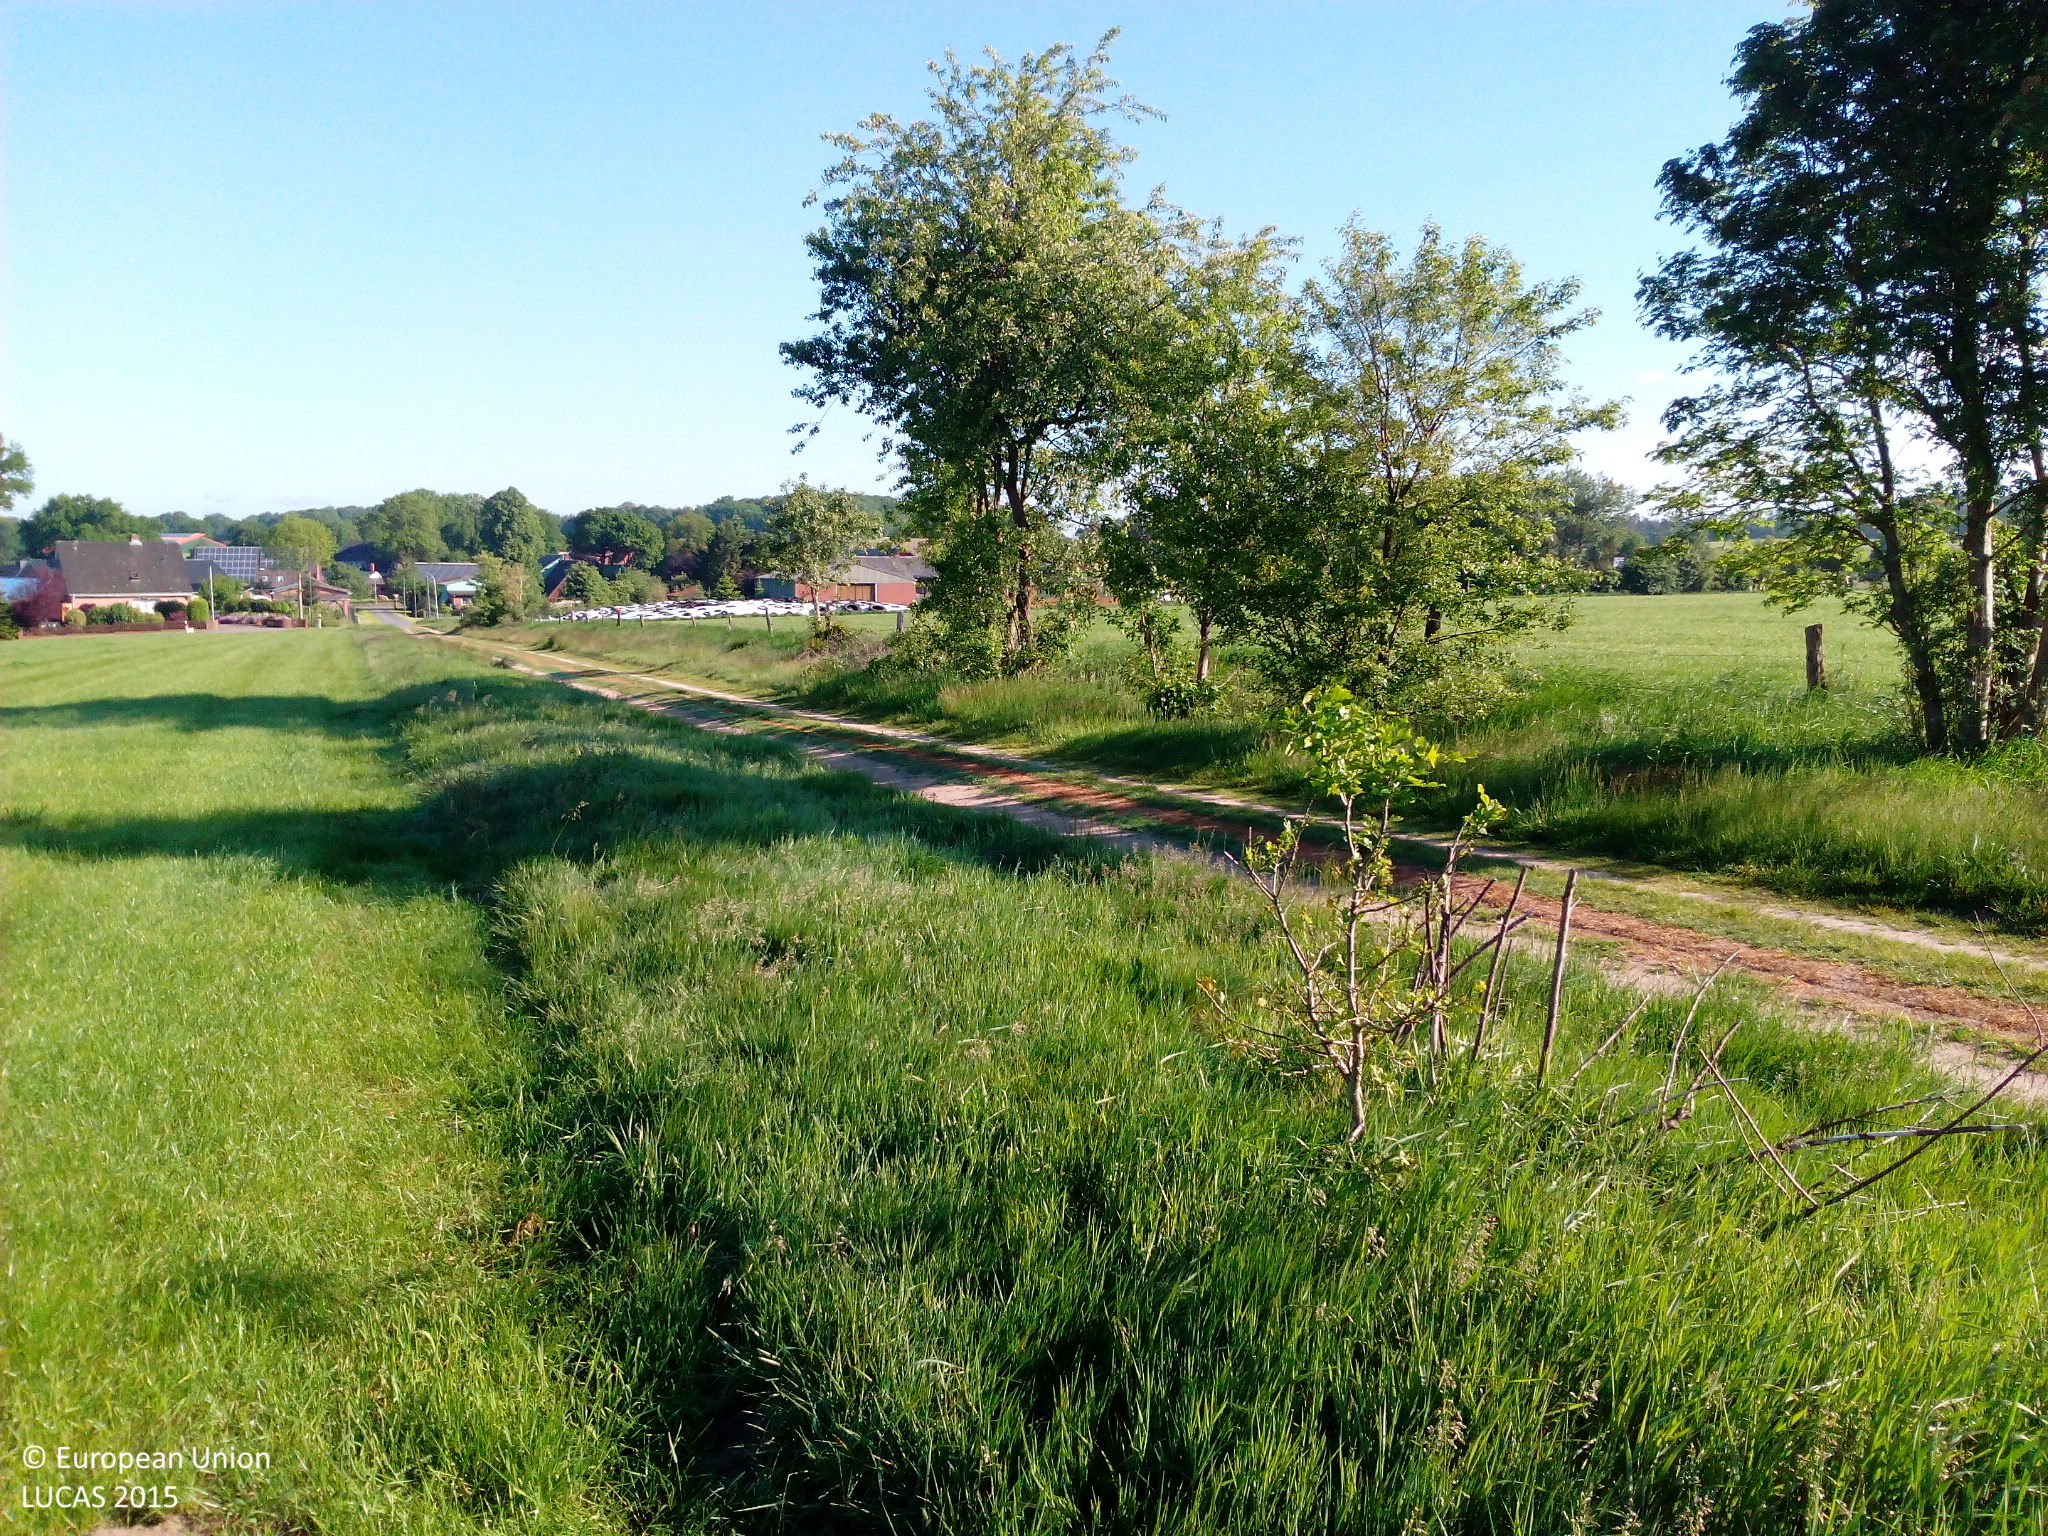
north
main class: Grassland
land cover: Grassland without tree/shrub cover
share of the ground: > 75 %
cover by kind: herbaceous plants 100 %
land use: Agriculture (excluding fallow land and kitchen gardens)
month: June
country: DE
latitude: 53.5961
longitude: 9.0788
